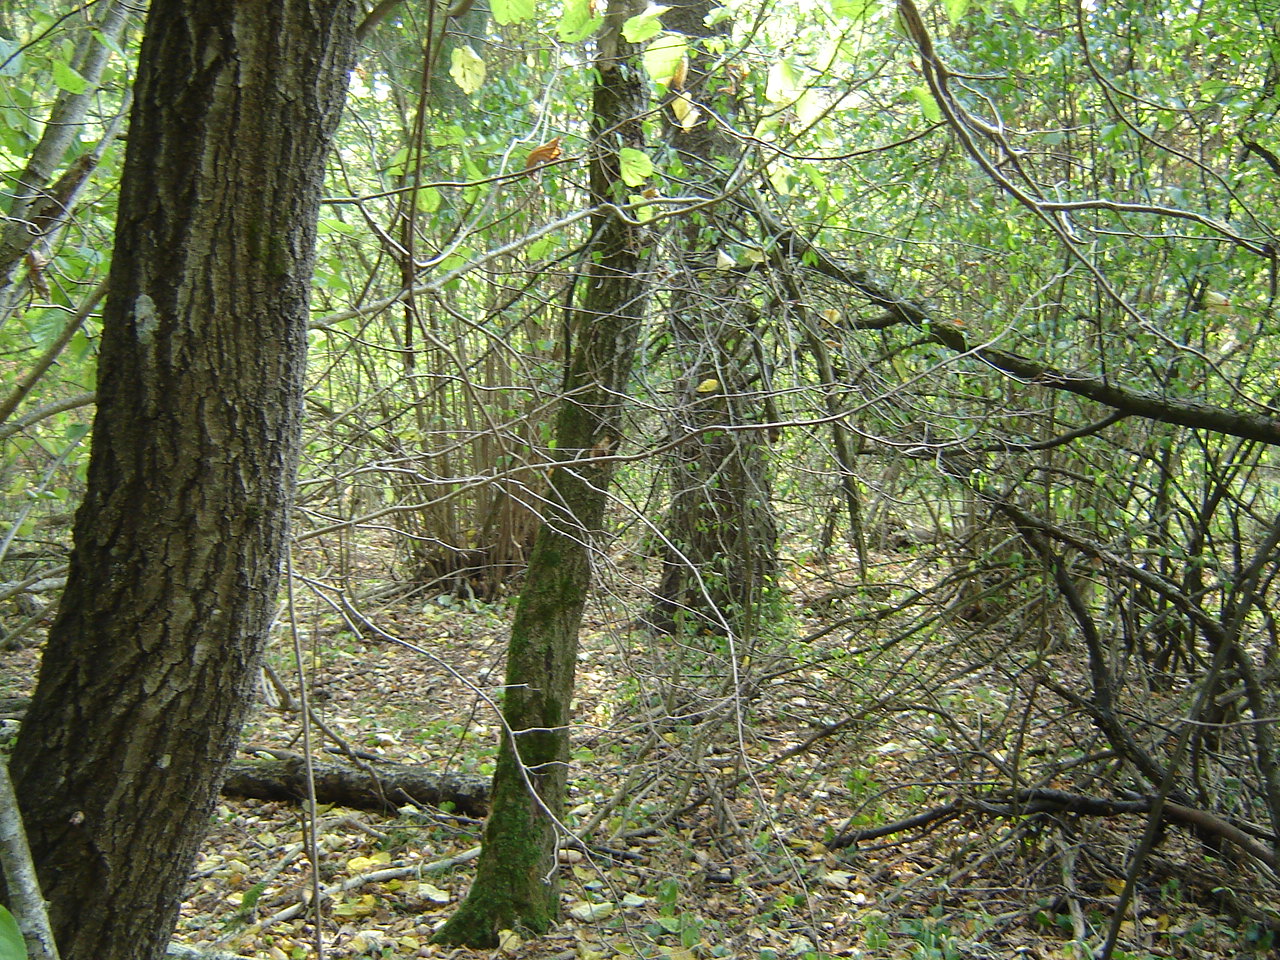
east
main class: Woodland
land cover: Spruce dominated mixed woodland
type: hemiboreal forest and nemoral coniferous forest and mixed broadleaved-coniferous forest
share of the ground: > 75 %
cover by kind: broadleaved forest trees 55 %, coniferous forest trees 30 %, unconsolidated bare surface 10 %, herbaceous plants 5 %
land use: Forestry
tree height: > 5 m
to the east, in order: Spruce dominated mixed woodland; Other structural elements; Pine dominated mixed woodland; Broadleaved woodland
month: September
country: LT
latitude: 54.5037
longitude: 25.2075
